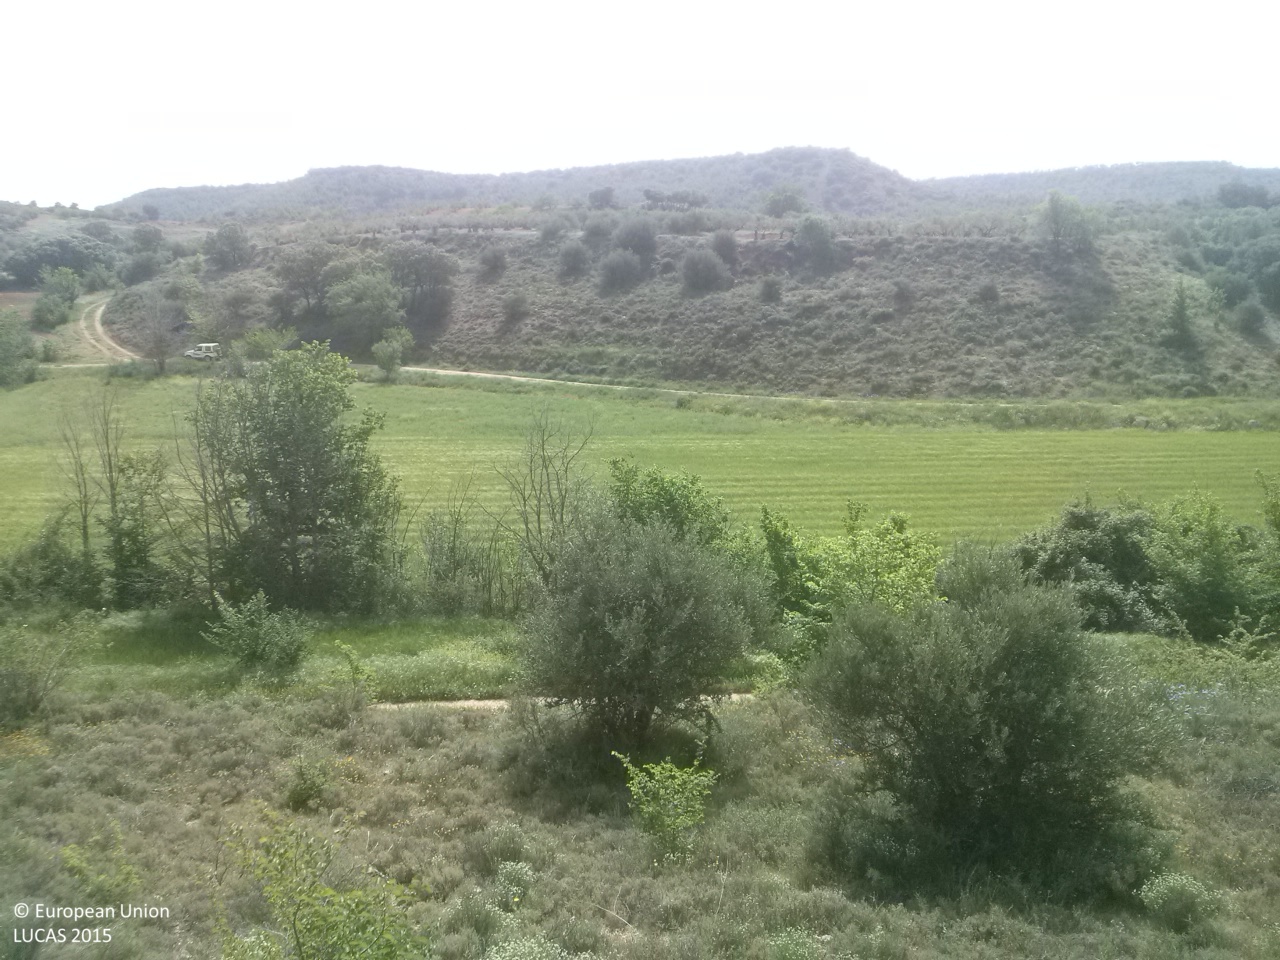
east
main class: Cropland
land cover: Olive groves
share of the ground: 10 - 25 %
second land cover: Shrubland without tree cover
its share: > 75 %
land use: Abandoned areas
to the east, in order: Olive groves; Shrubland without tree cover; Grass margins; Tracks; Grass margins; Groves; Grass margins; Barley; Dry pulses; Grass margins; Tracks; Shrubland without tree cover; Shrubland with sparse tree cover; Olive groves
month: May
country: ES
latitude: 39.9720
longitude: -2.5347
